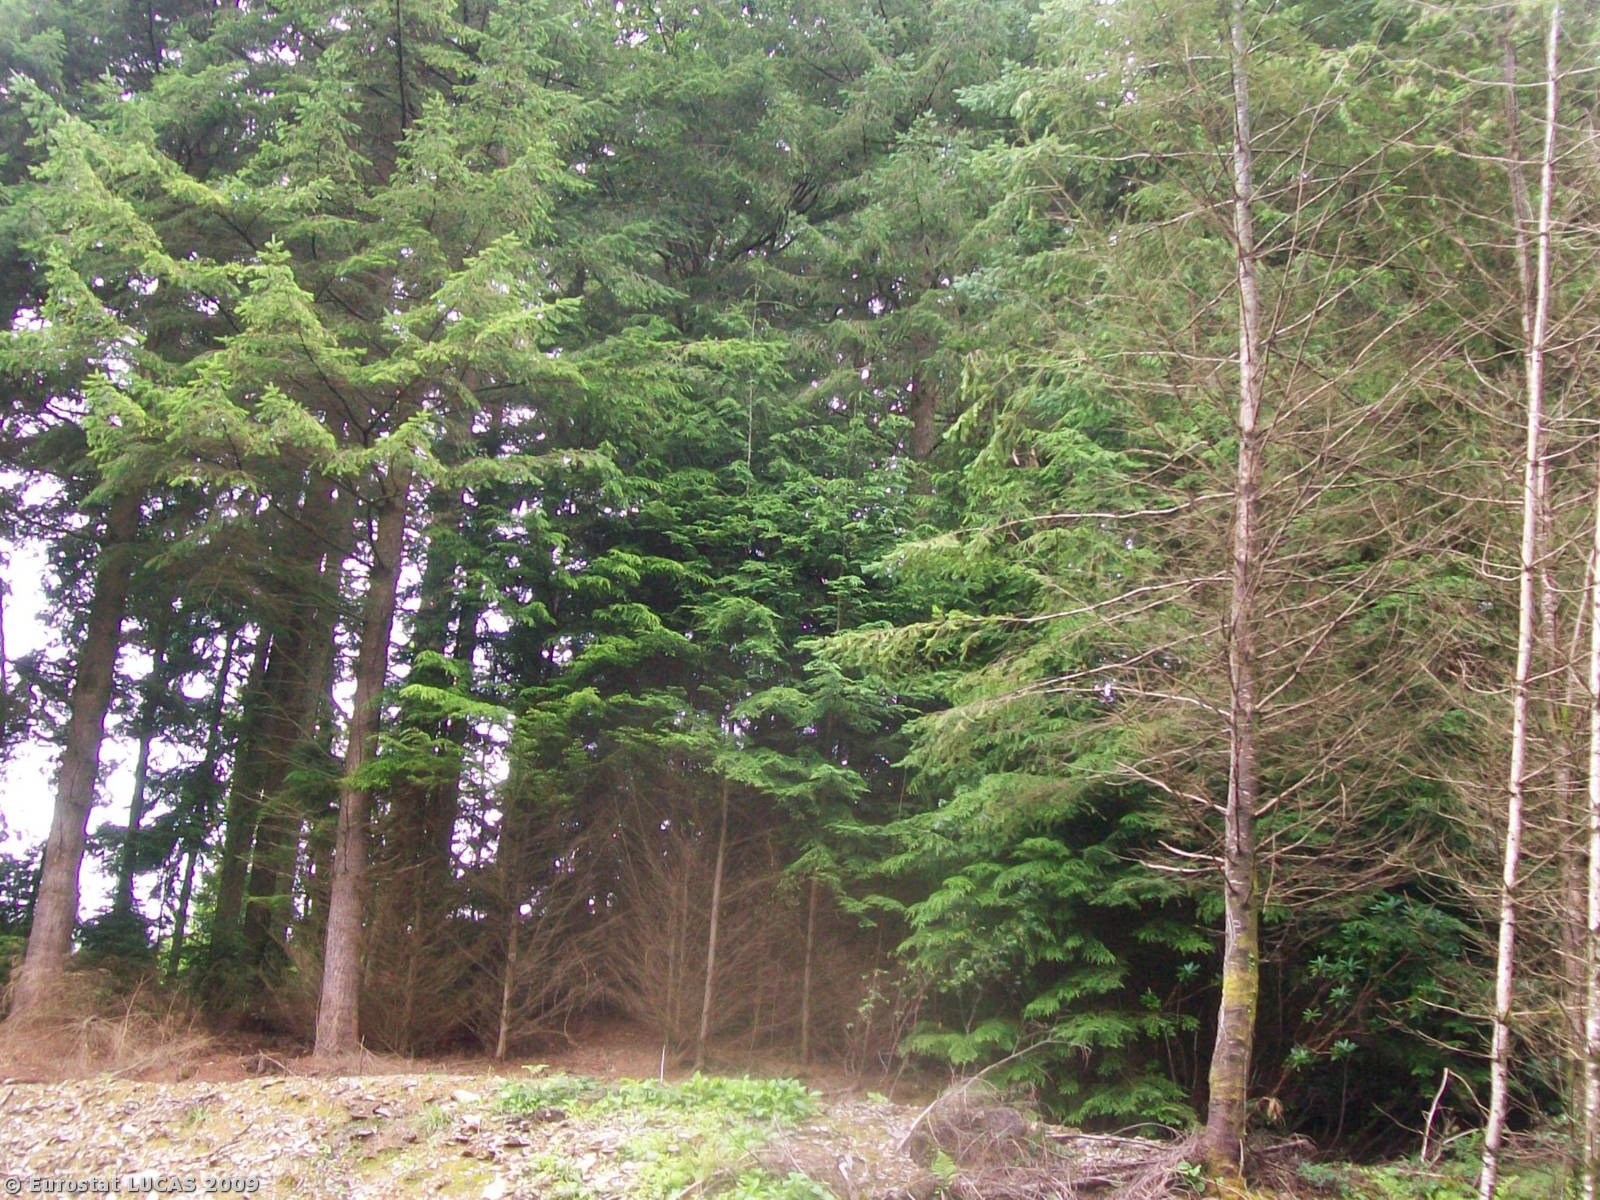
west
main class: Woodland
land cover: Coniferous woodland
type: plantations and self-sown exotic forest
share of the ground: > 75 %
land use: Forestry
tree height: > 5 m
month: July
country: GB
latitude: 52.6341
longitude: -3.8778
